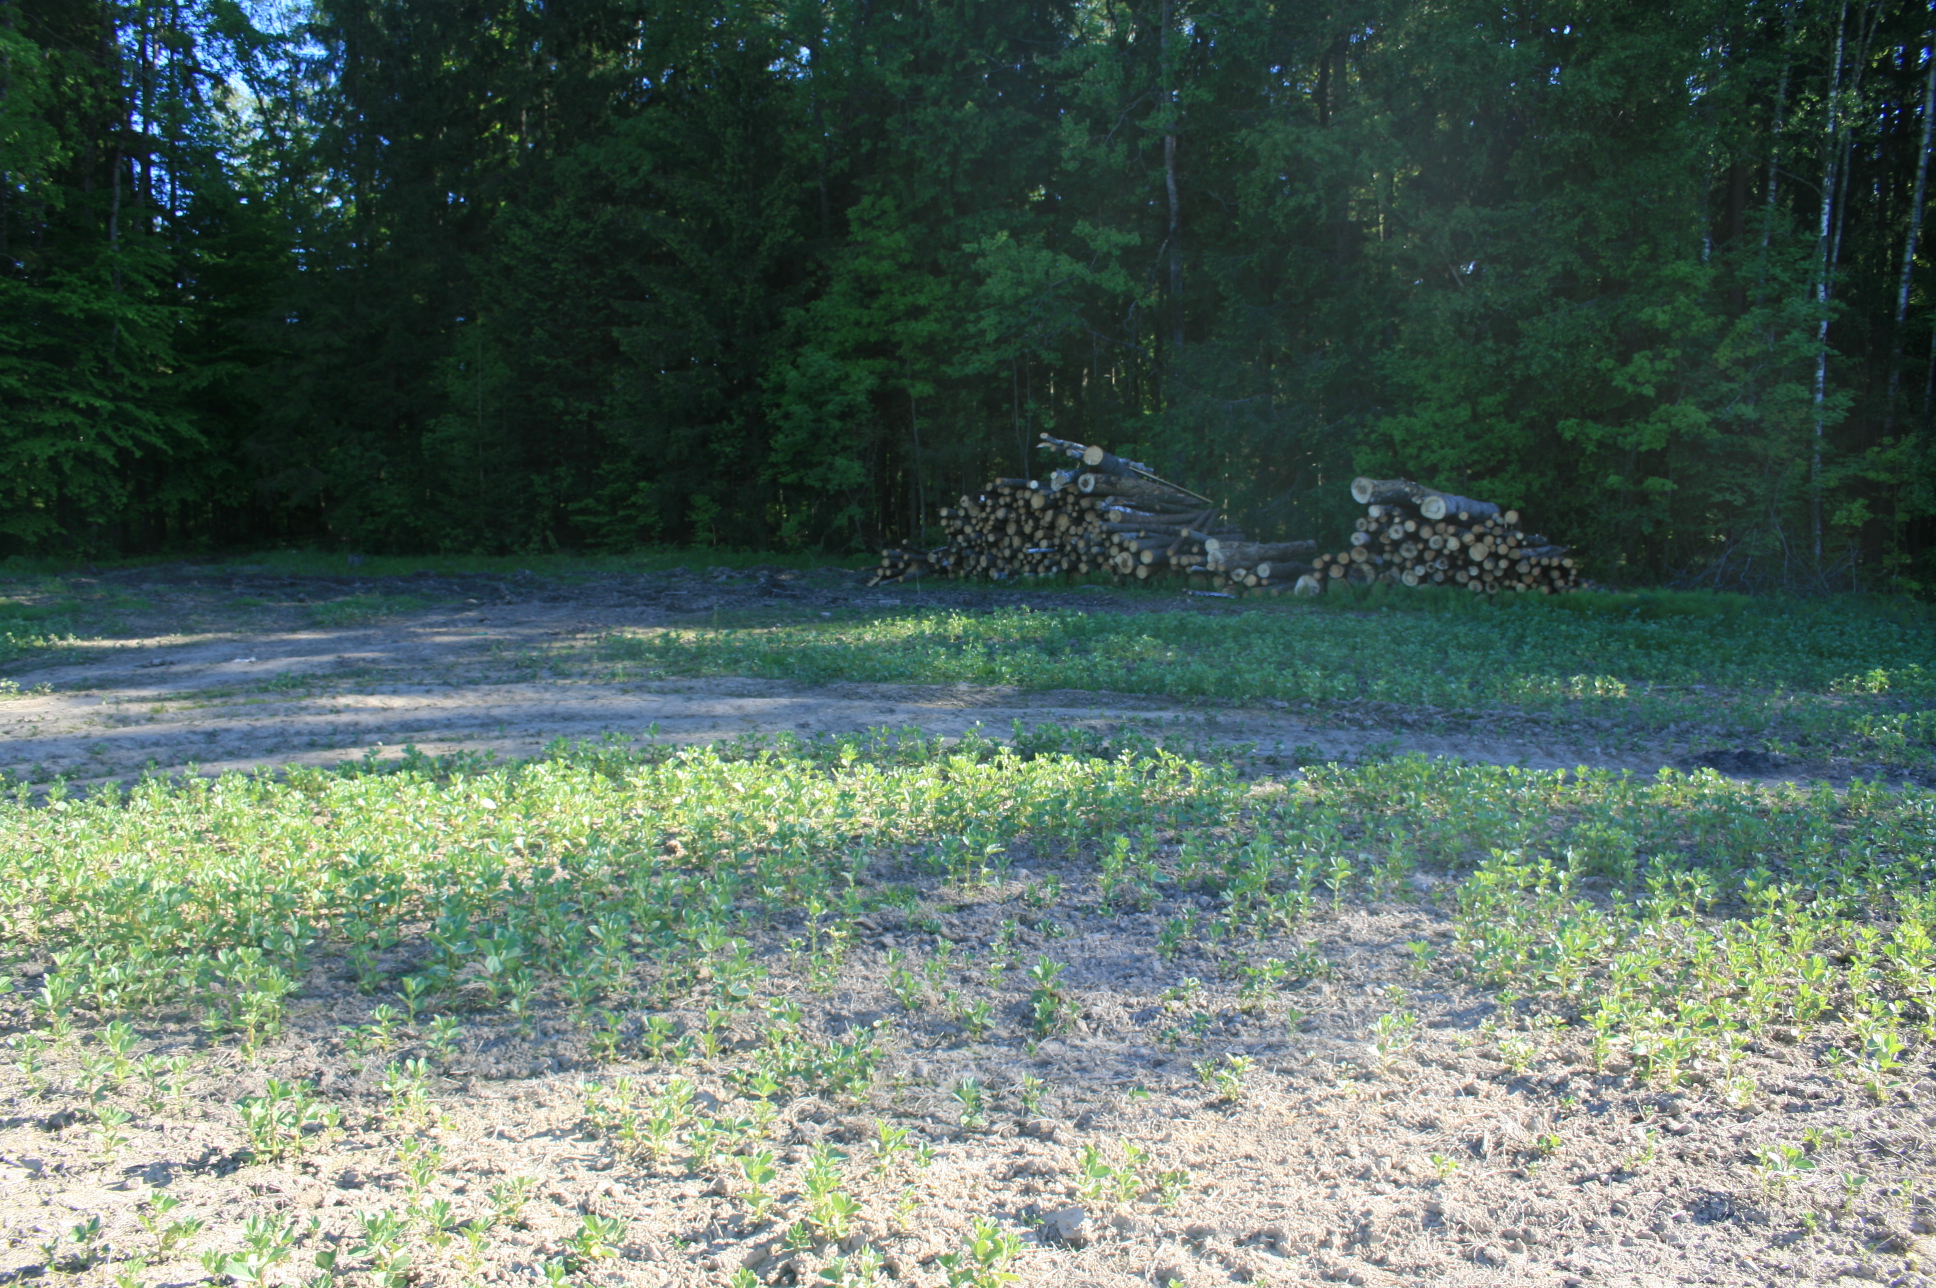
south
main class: Cropland
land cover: Dry pulses
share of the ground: 50 - 75 %
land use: Agriculture (excluding fallow land and kitchen gardens)
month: June
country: LT
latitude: 55.9508
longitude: 21.3971
